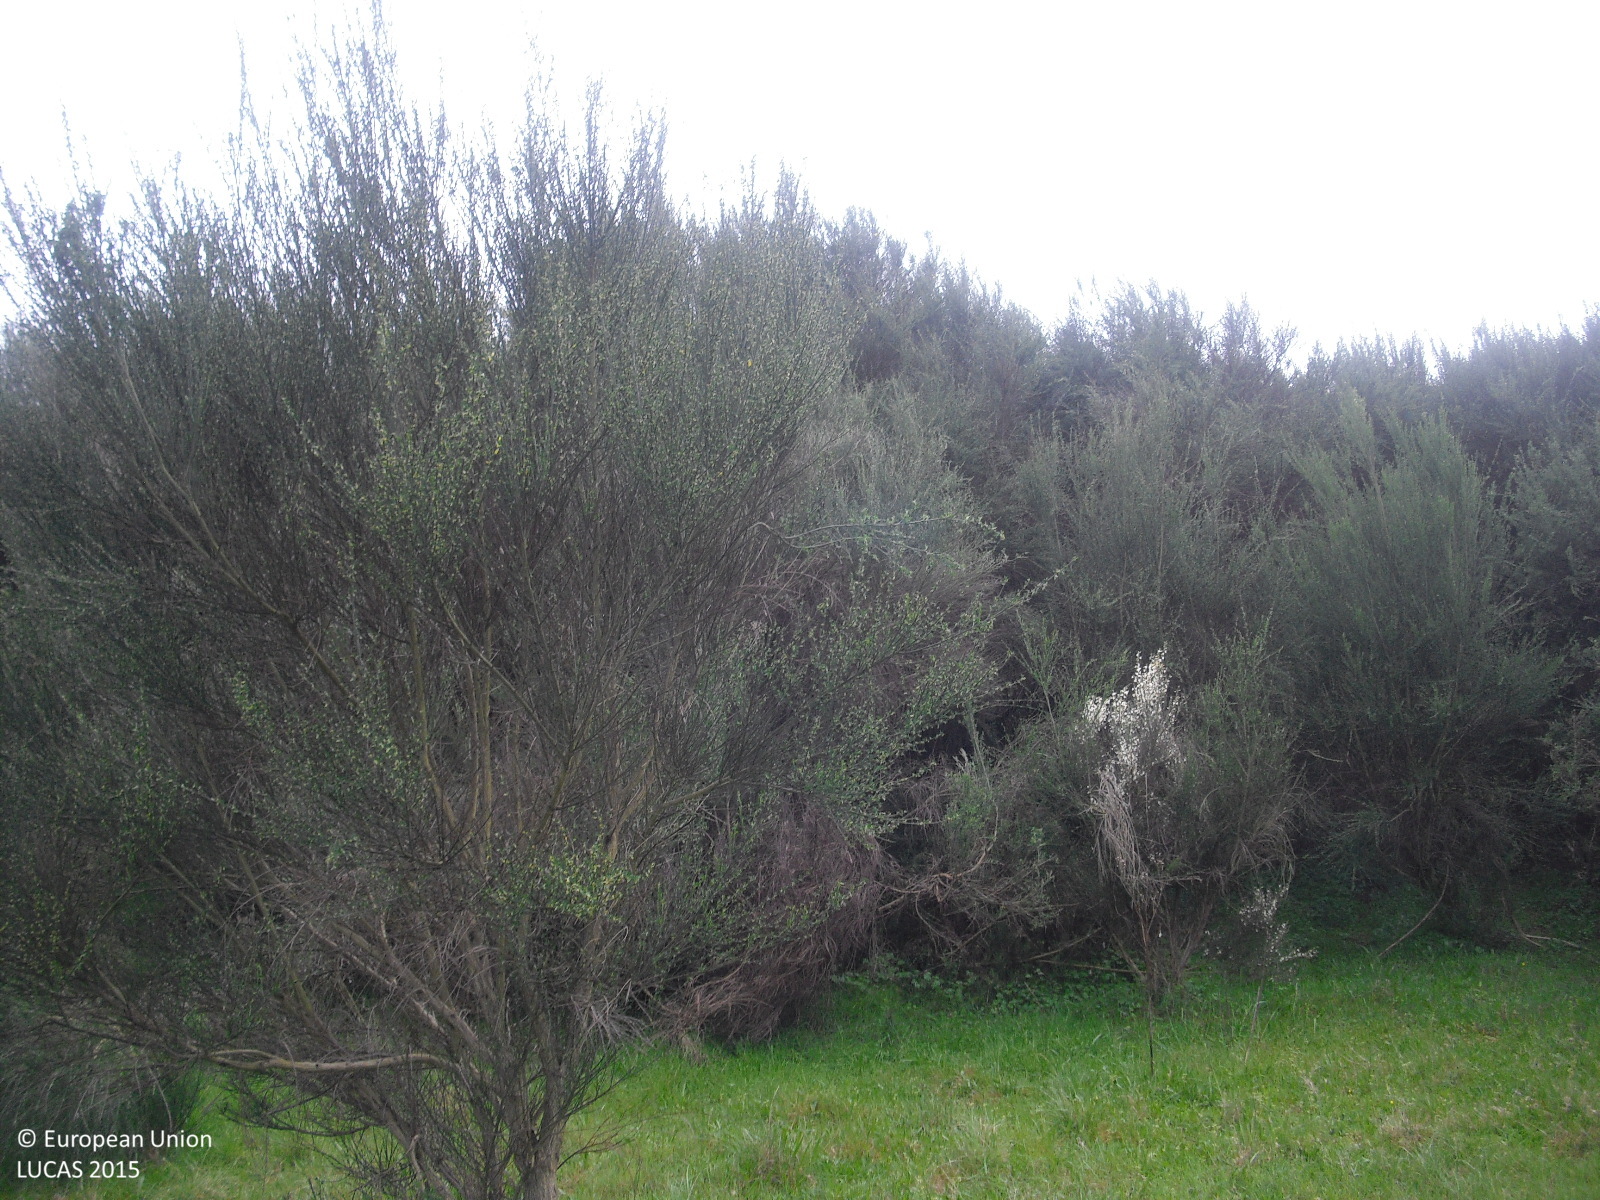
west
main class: Shrubland
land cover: Shrubland with sparse tree cover
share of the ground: 50 - 75 %
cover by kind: herbaceous plants 55 %, shrubs 40 %, broadleaved forest trees 5 %
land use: Agriculture (excluding fallow land and kitchen gardens)
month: April
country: ES
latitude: 41.9433
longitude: -7.5159
